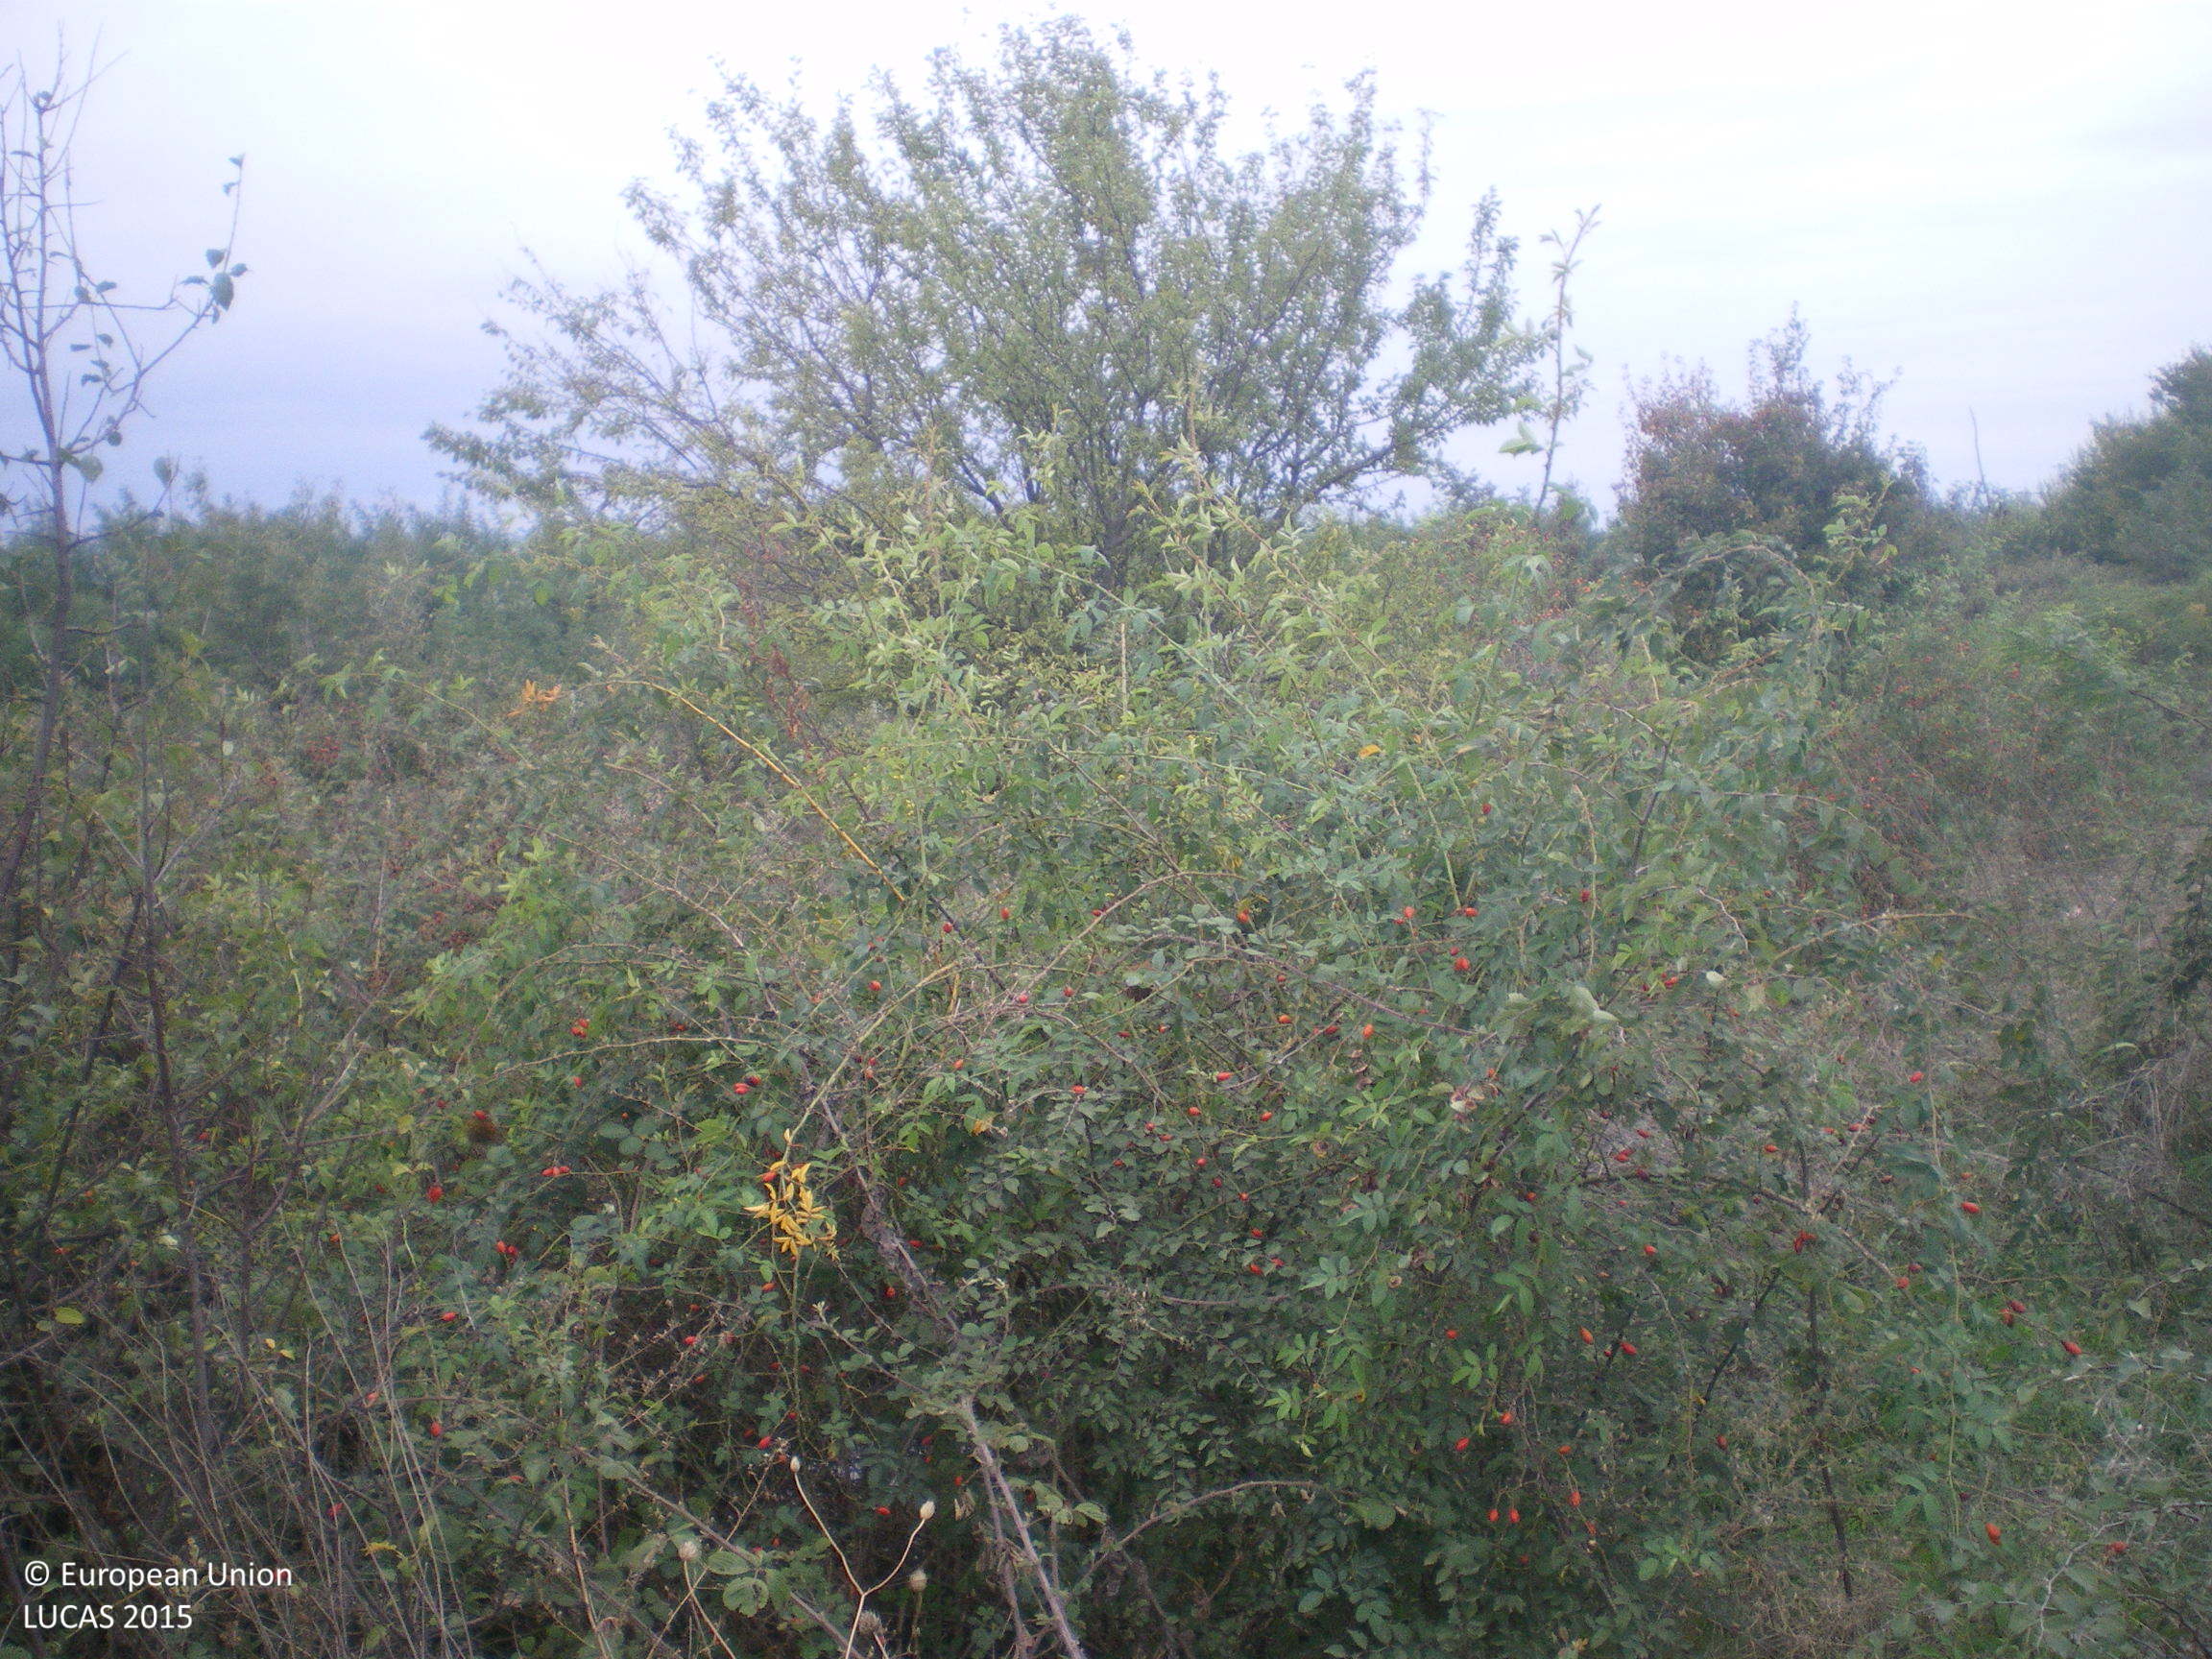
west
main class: Shrubland
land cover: Shrubland with sparse tree cover
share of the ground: > 75 %
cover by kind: shrubs 60 %, herbaceous plants 35 %, broadleaved forest trees 5 %
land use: Semi-natural and natural areas not in use
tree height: > 5 m
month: October
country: BG
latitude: 41.8046
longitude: 26.1677
